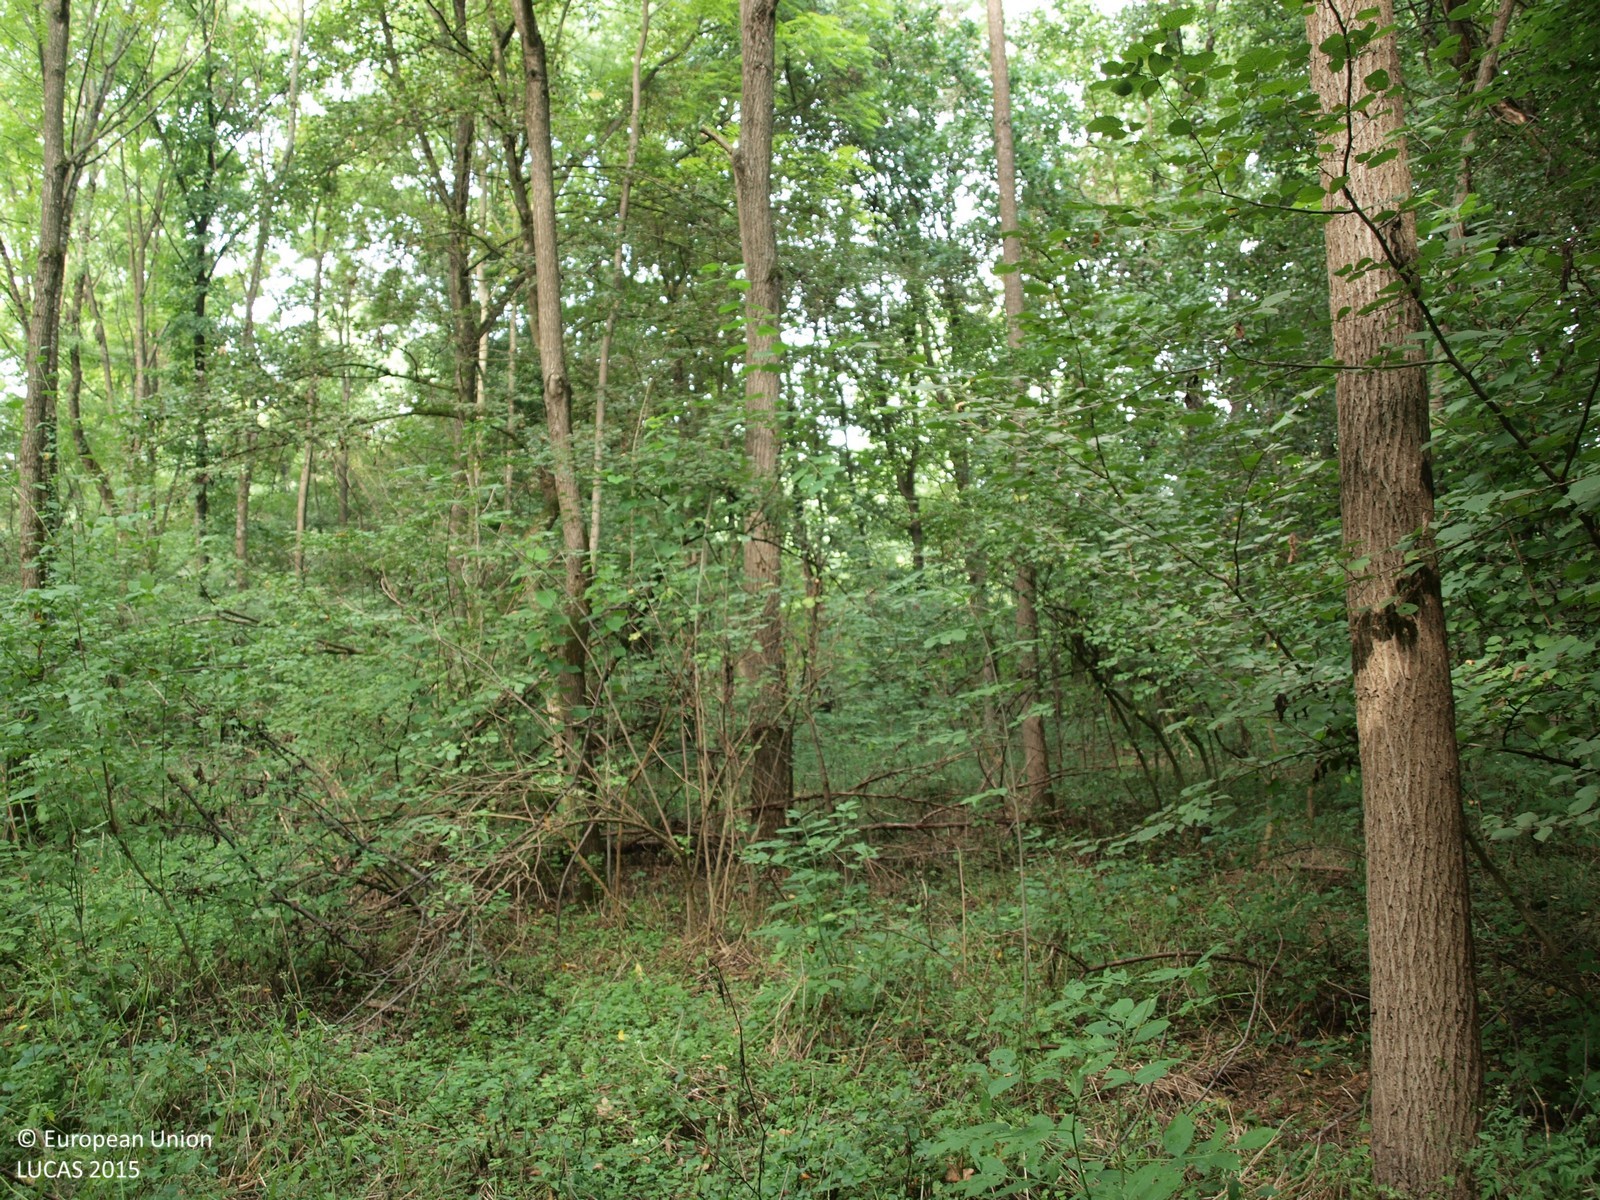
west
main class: Woodland
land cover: Broadleaved woodland
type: floodplain forest
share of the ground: > 75 %
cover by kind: broadleaved forest trees 100 %
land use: Forestry
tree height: > 5 m
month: September
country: HR
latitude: 45.7419
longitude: 16.1288
